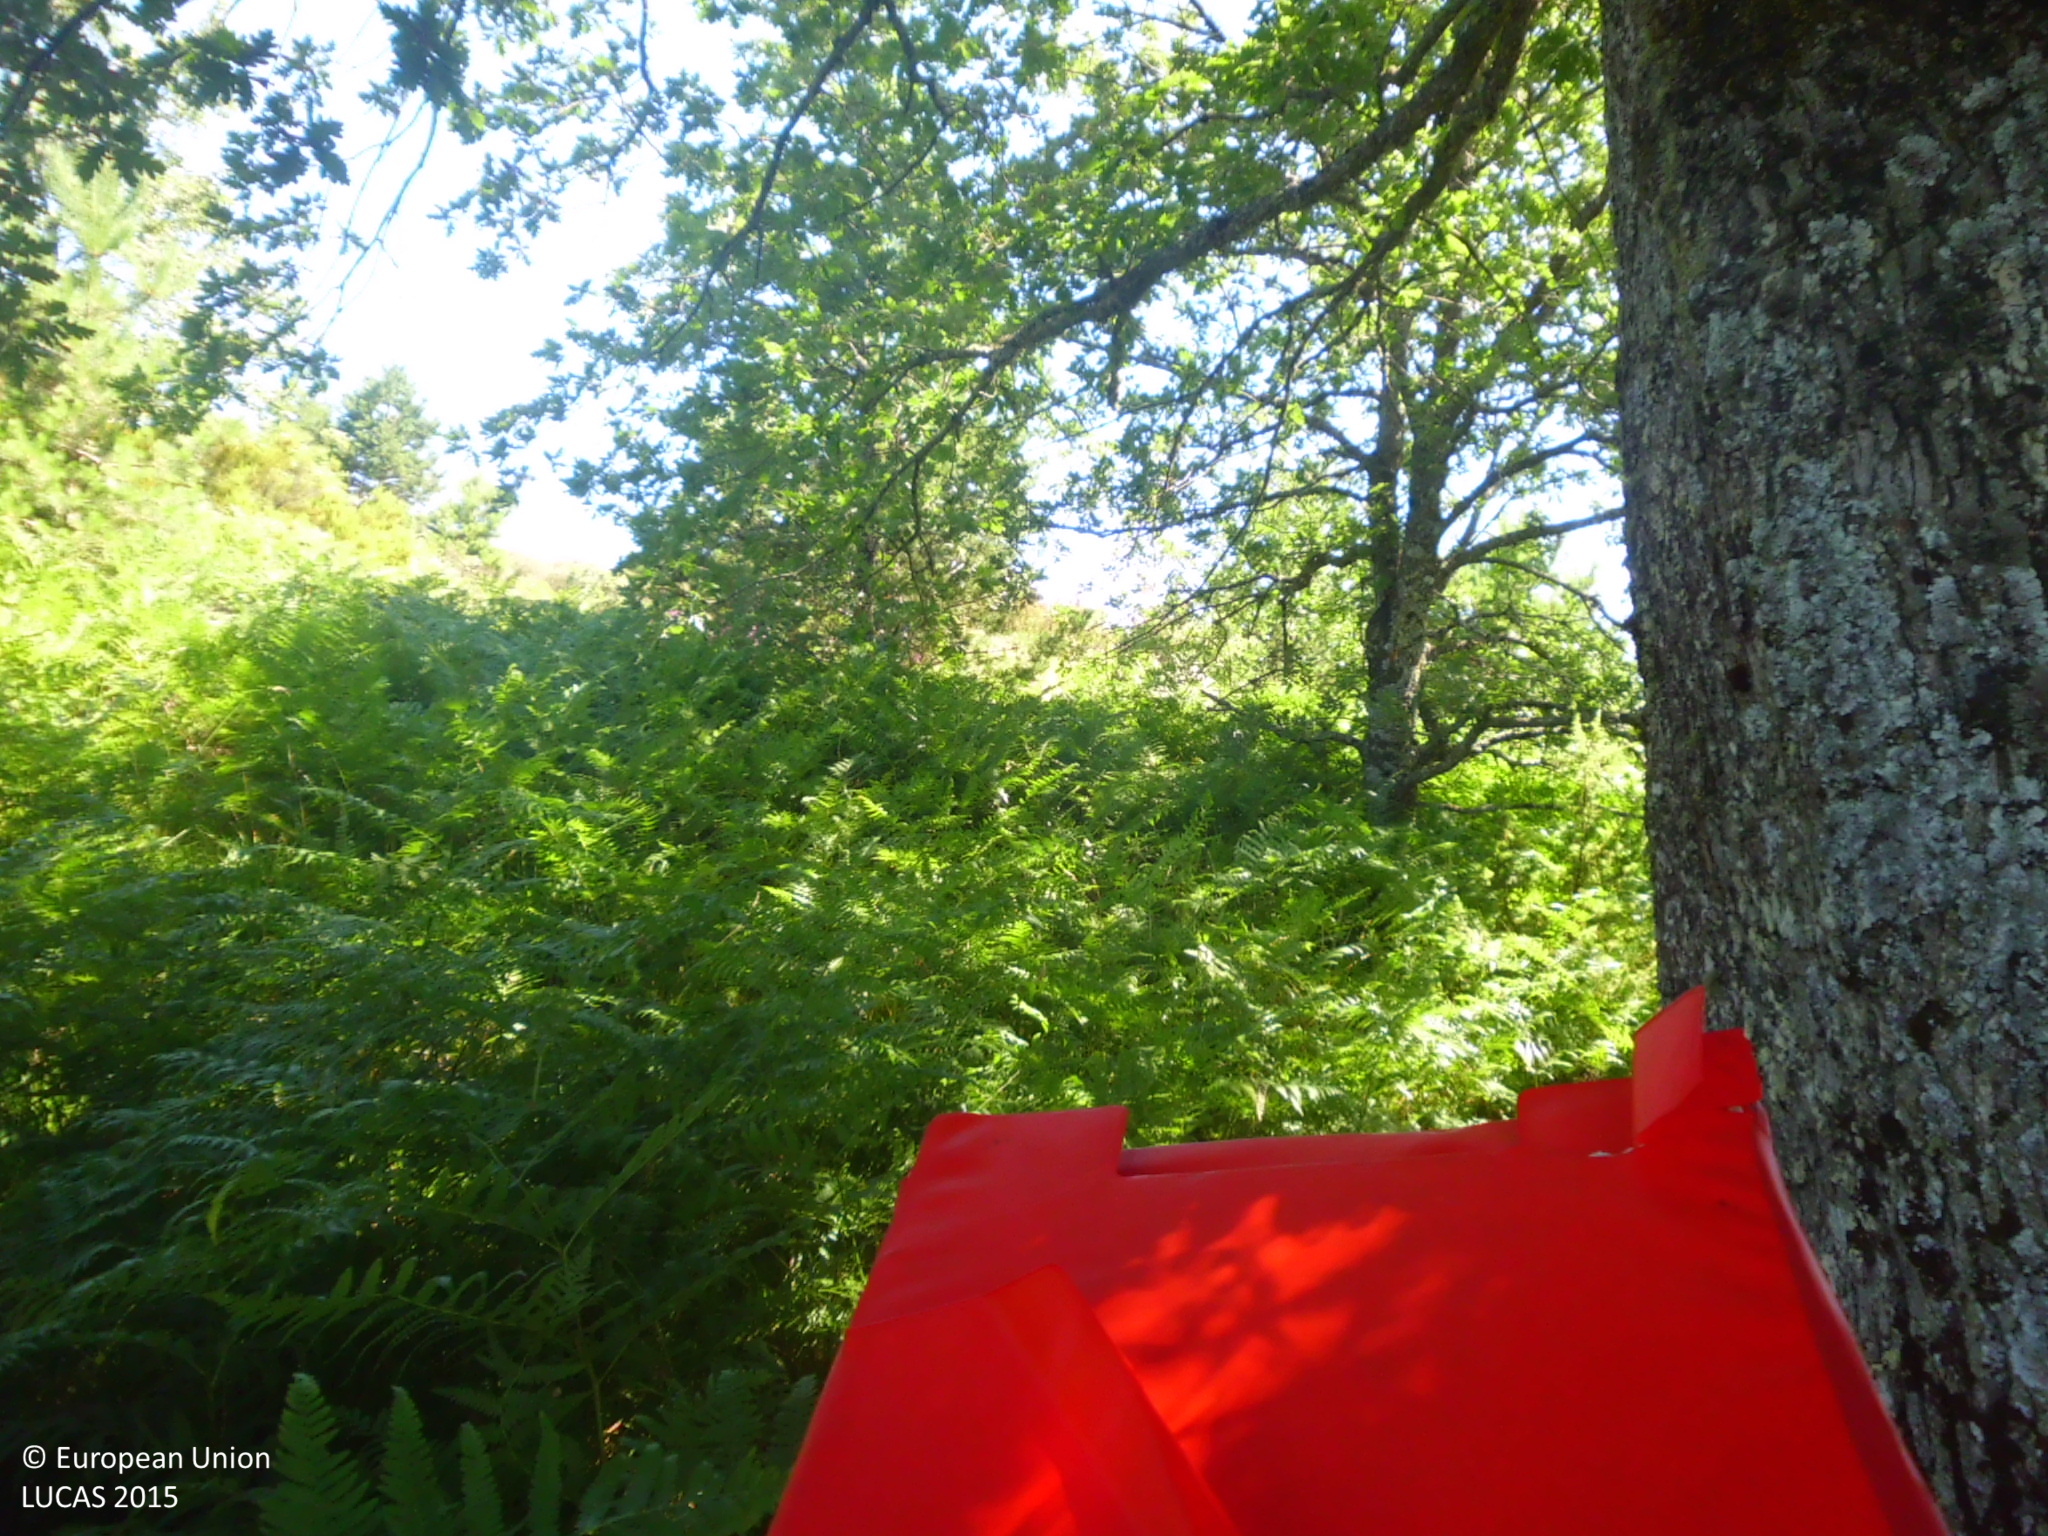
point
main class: Woodland
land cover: Broadleaved woodland
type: acidophilous oak and oak-birch forest
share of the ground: 10 - 25 %
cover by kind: shrubs 60 %, broadleaved forest trees 20 %, herbaceous plants 20 %
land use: Agriculture (excluding fallow land and kitchen gardens)
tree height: > 5 m
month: July
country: ES
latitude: 42.3155
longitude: -3.3405
